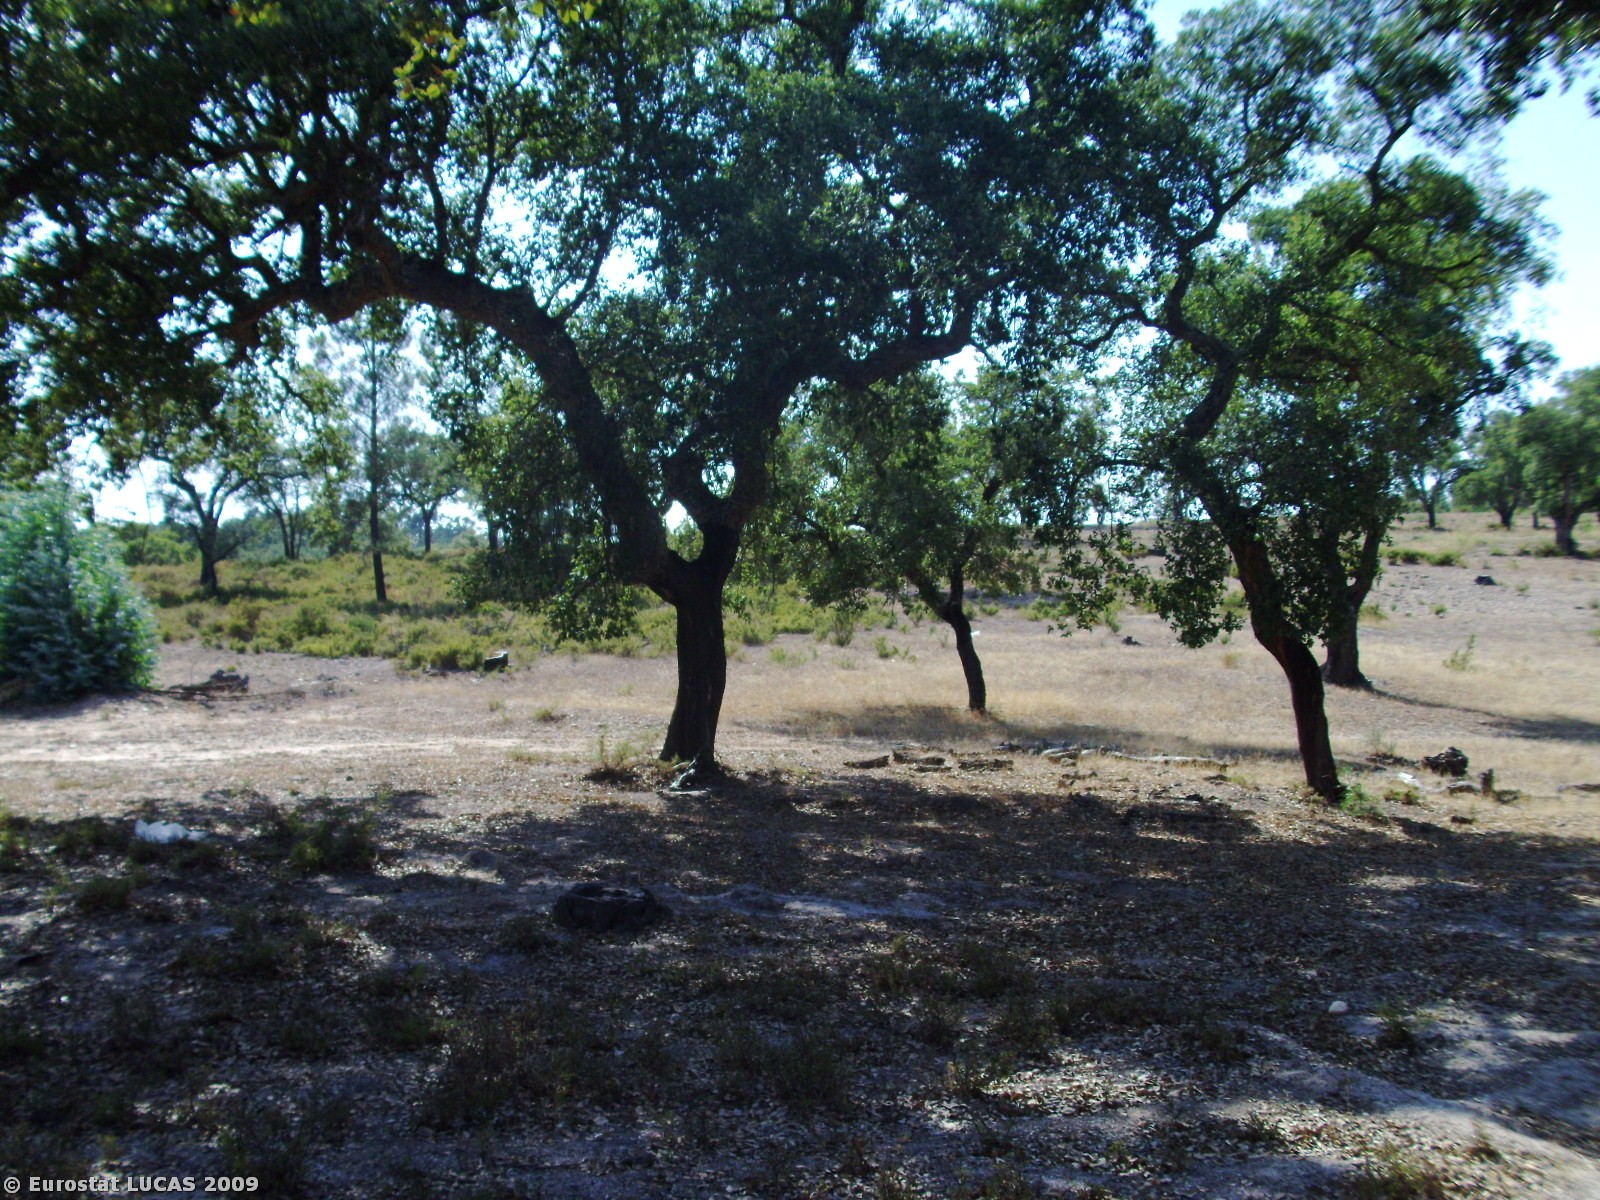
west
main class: Woodland
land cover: Broadleaved woodland
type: broadleaved evergreen forest
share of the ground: > 75 %
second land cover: Spontaneously vegetated surfaces
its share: 10 - 25 %
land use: Forestry
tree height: > 5 m
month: August
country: PT
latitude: 39.3218
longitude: -8.0240
